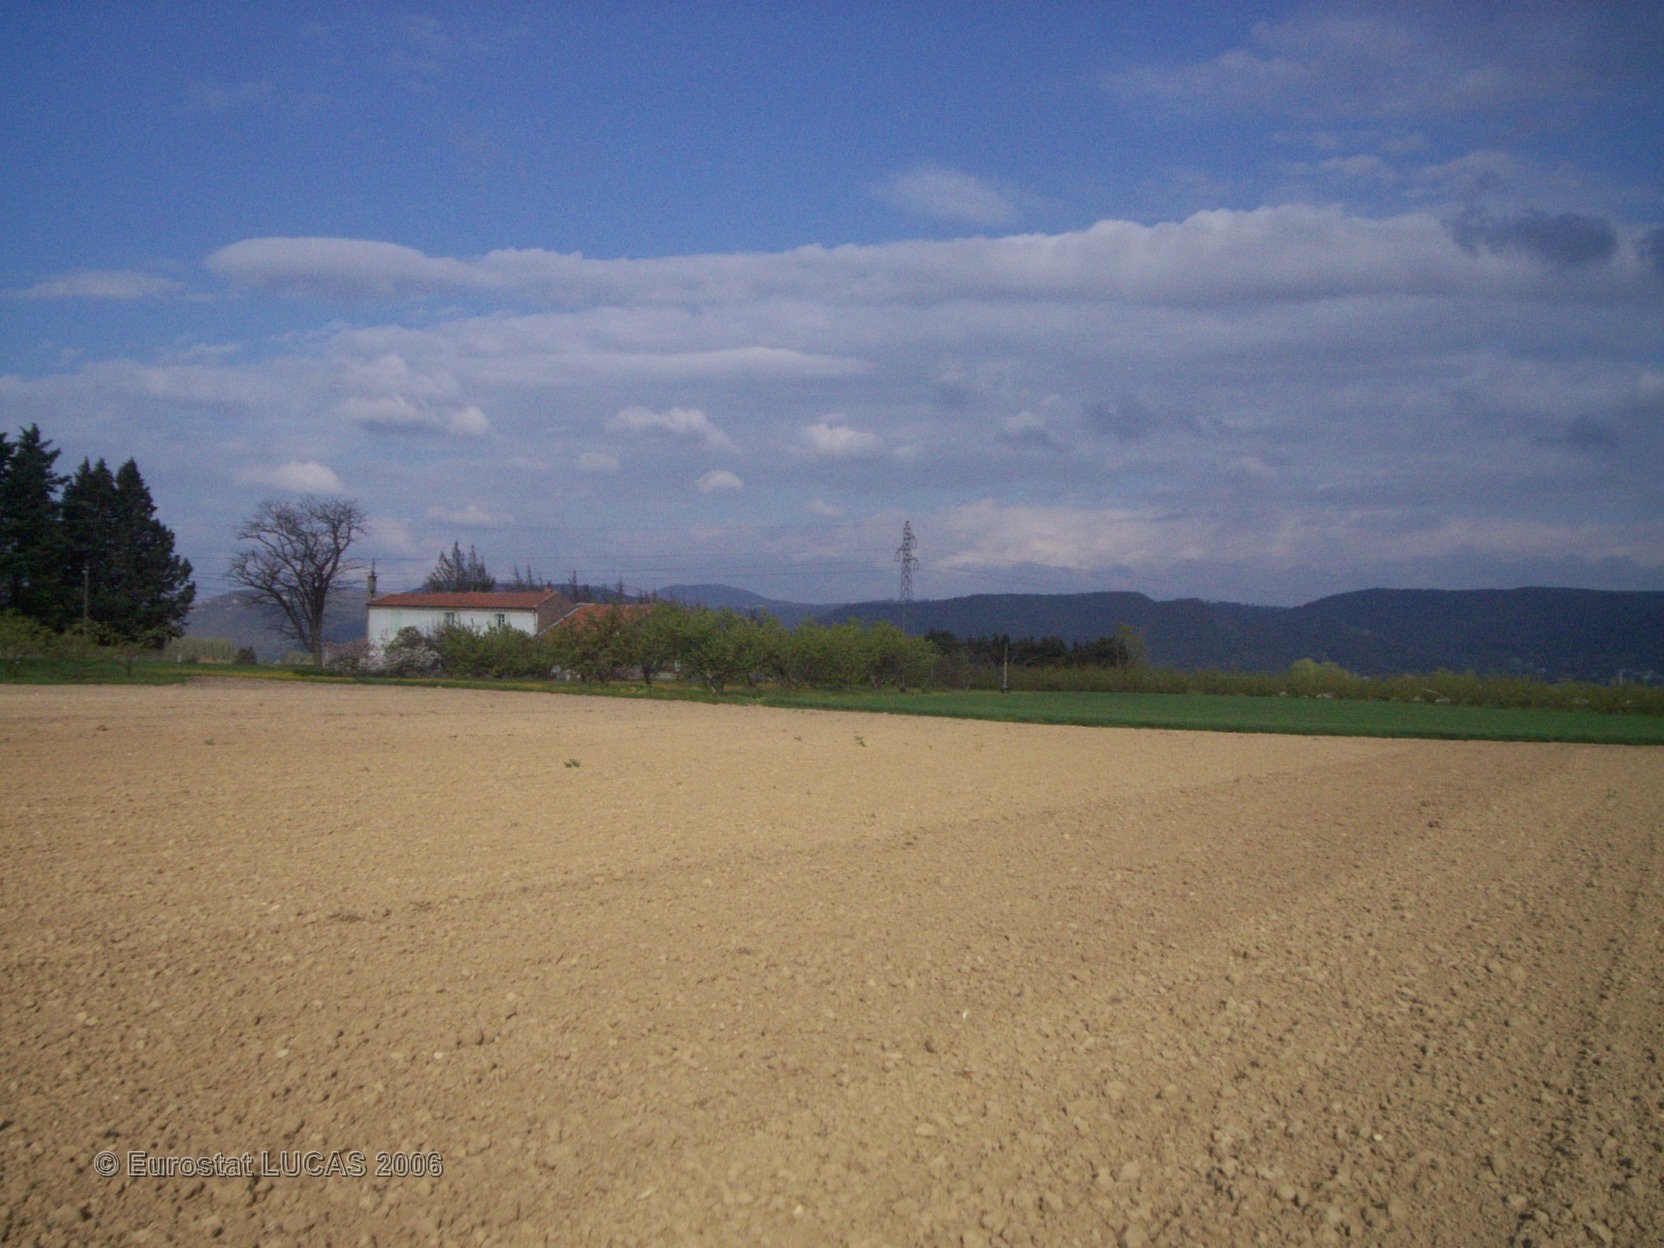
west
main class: Cropland
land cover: Sunflower
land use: Agriculture (excluding fallow land and kitchen gardens)
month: June
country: FR
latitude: 44.7809
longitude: 4.8120
